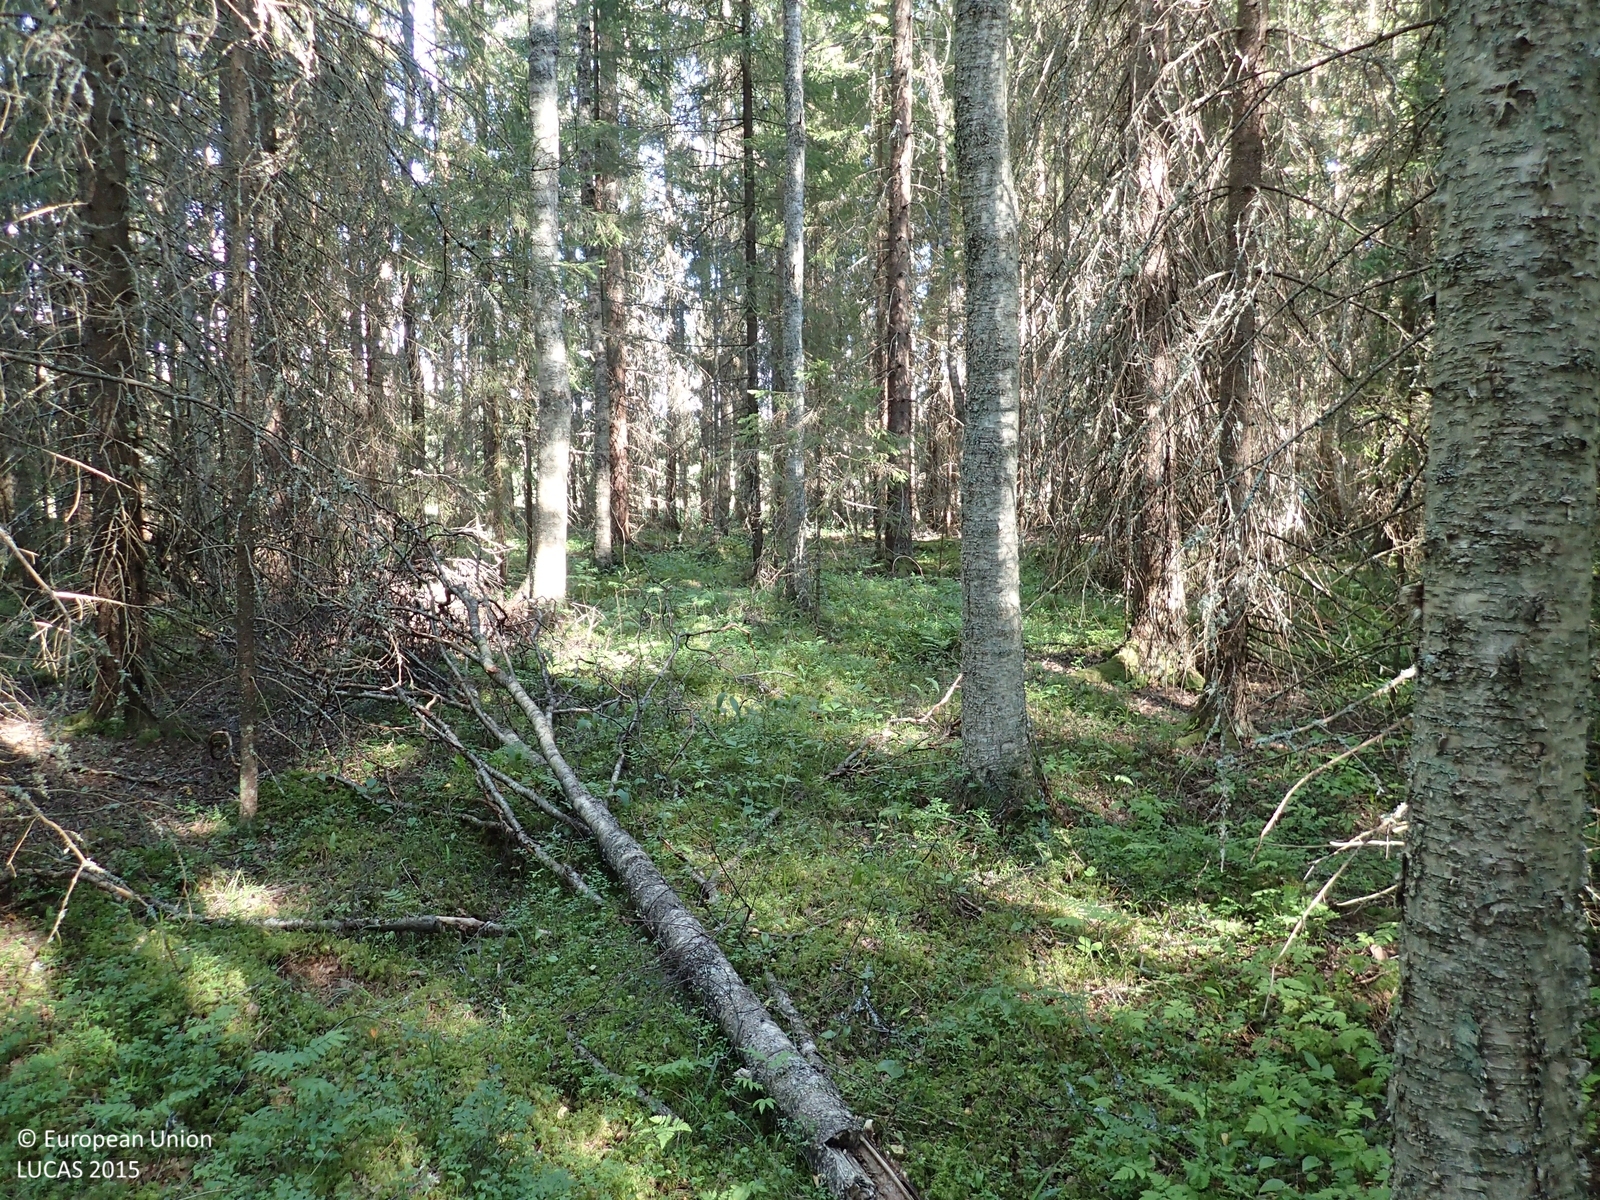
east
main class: Woodland
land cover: Spruce dominated coniferous woodland
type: boreal forest
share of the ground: > 75 %
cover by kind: coniferous forest trees 70 %, broadleaved forest trees 15 %, herbaceous plants 10 %, lichens and mosses 5 %
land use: Forestry
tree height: > 5 m
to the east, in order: Spruce dominated coniferous woodland; Temporary grasslands; Ditches and canals; Grassland with sparse tree/shrub cover; Ditches and canals; Broadleaved woodland; Ditches and canals; Grass margins; Paved roads, cycling and walking lanes; Grass margins; Ditches and canals; Shruby margins; Electric lines; Temporary grasslands; Ditches and canals; Temporary grasslands
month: August
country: FI
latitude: 62.7452
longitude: 22.0859
